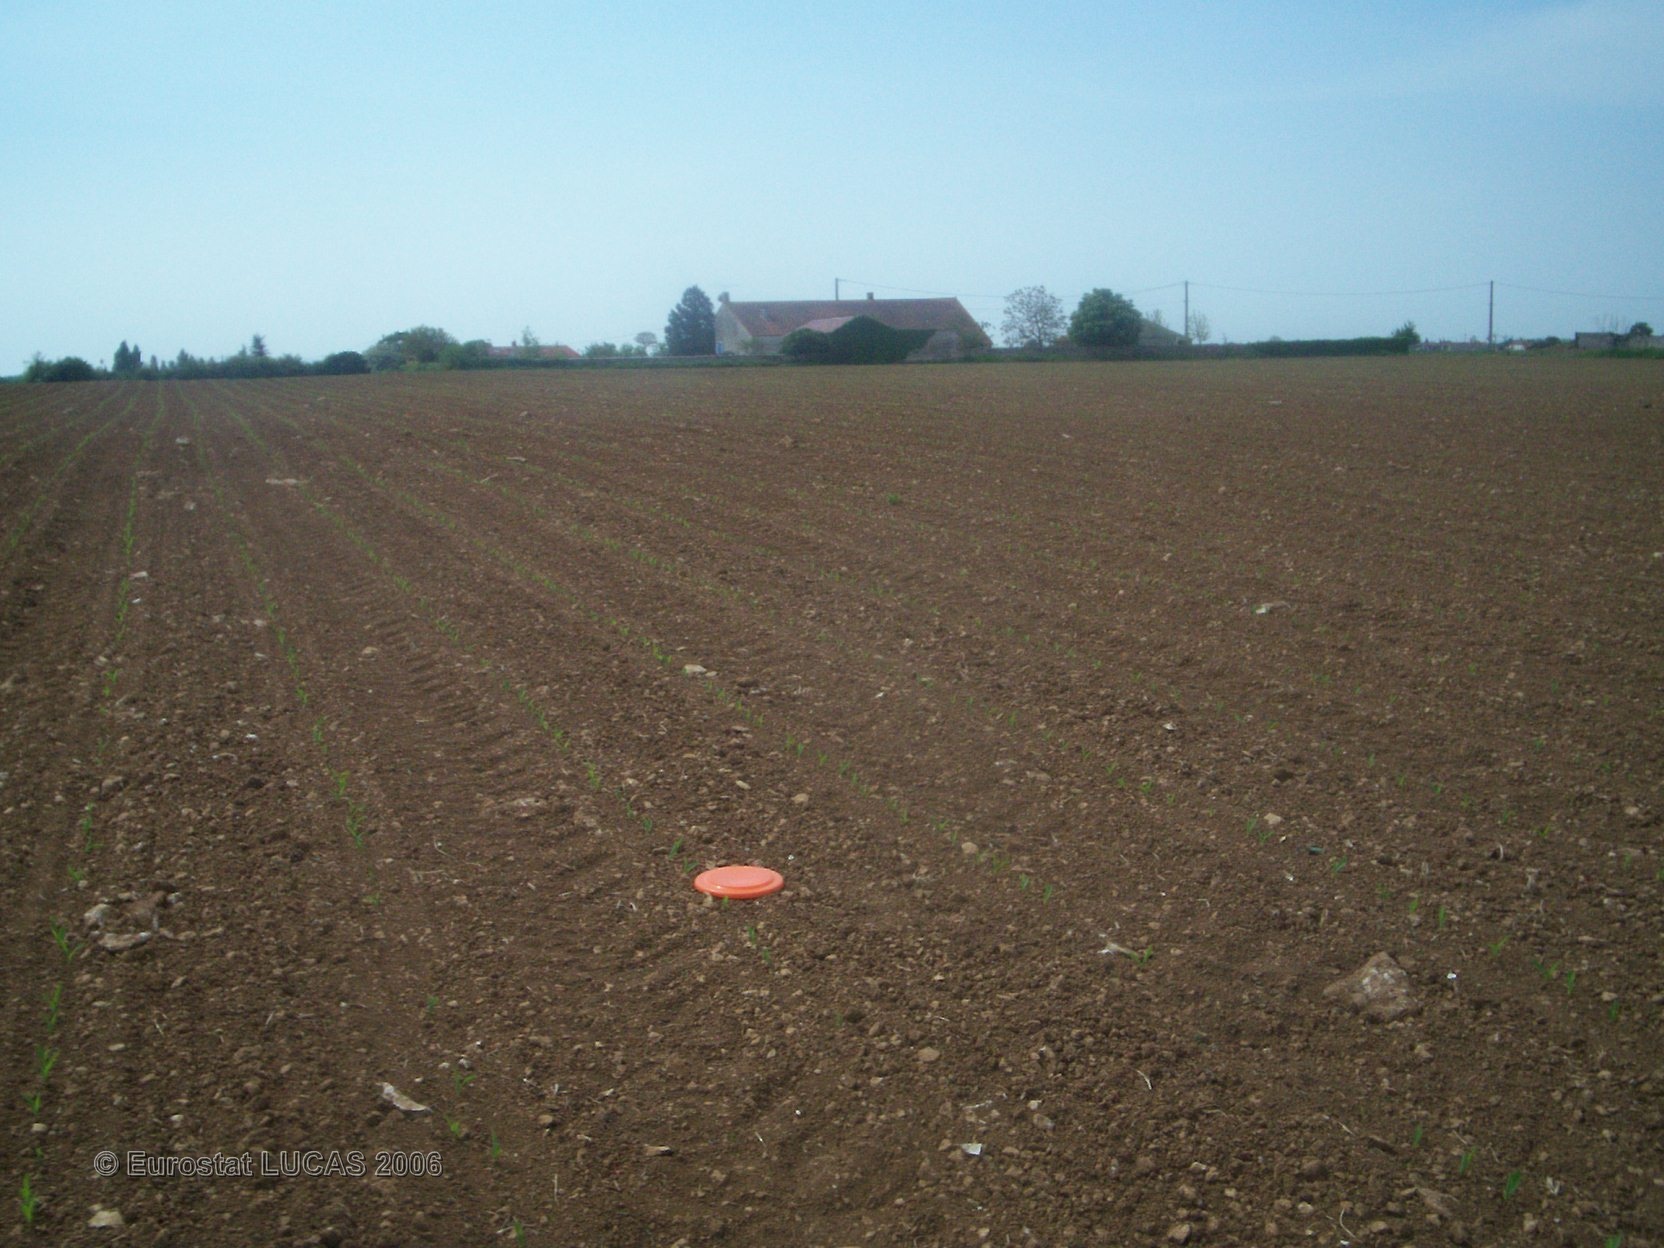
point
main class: Cropland
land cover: Maize
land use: Agriculture (excluding fallow land and kitchen gardens)
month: May
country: FR
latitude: 46.4741
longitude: -0.9848
